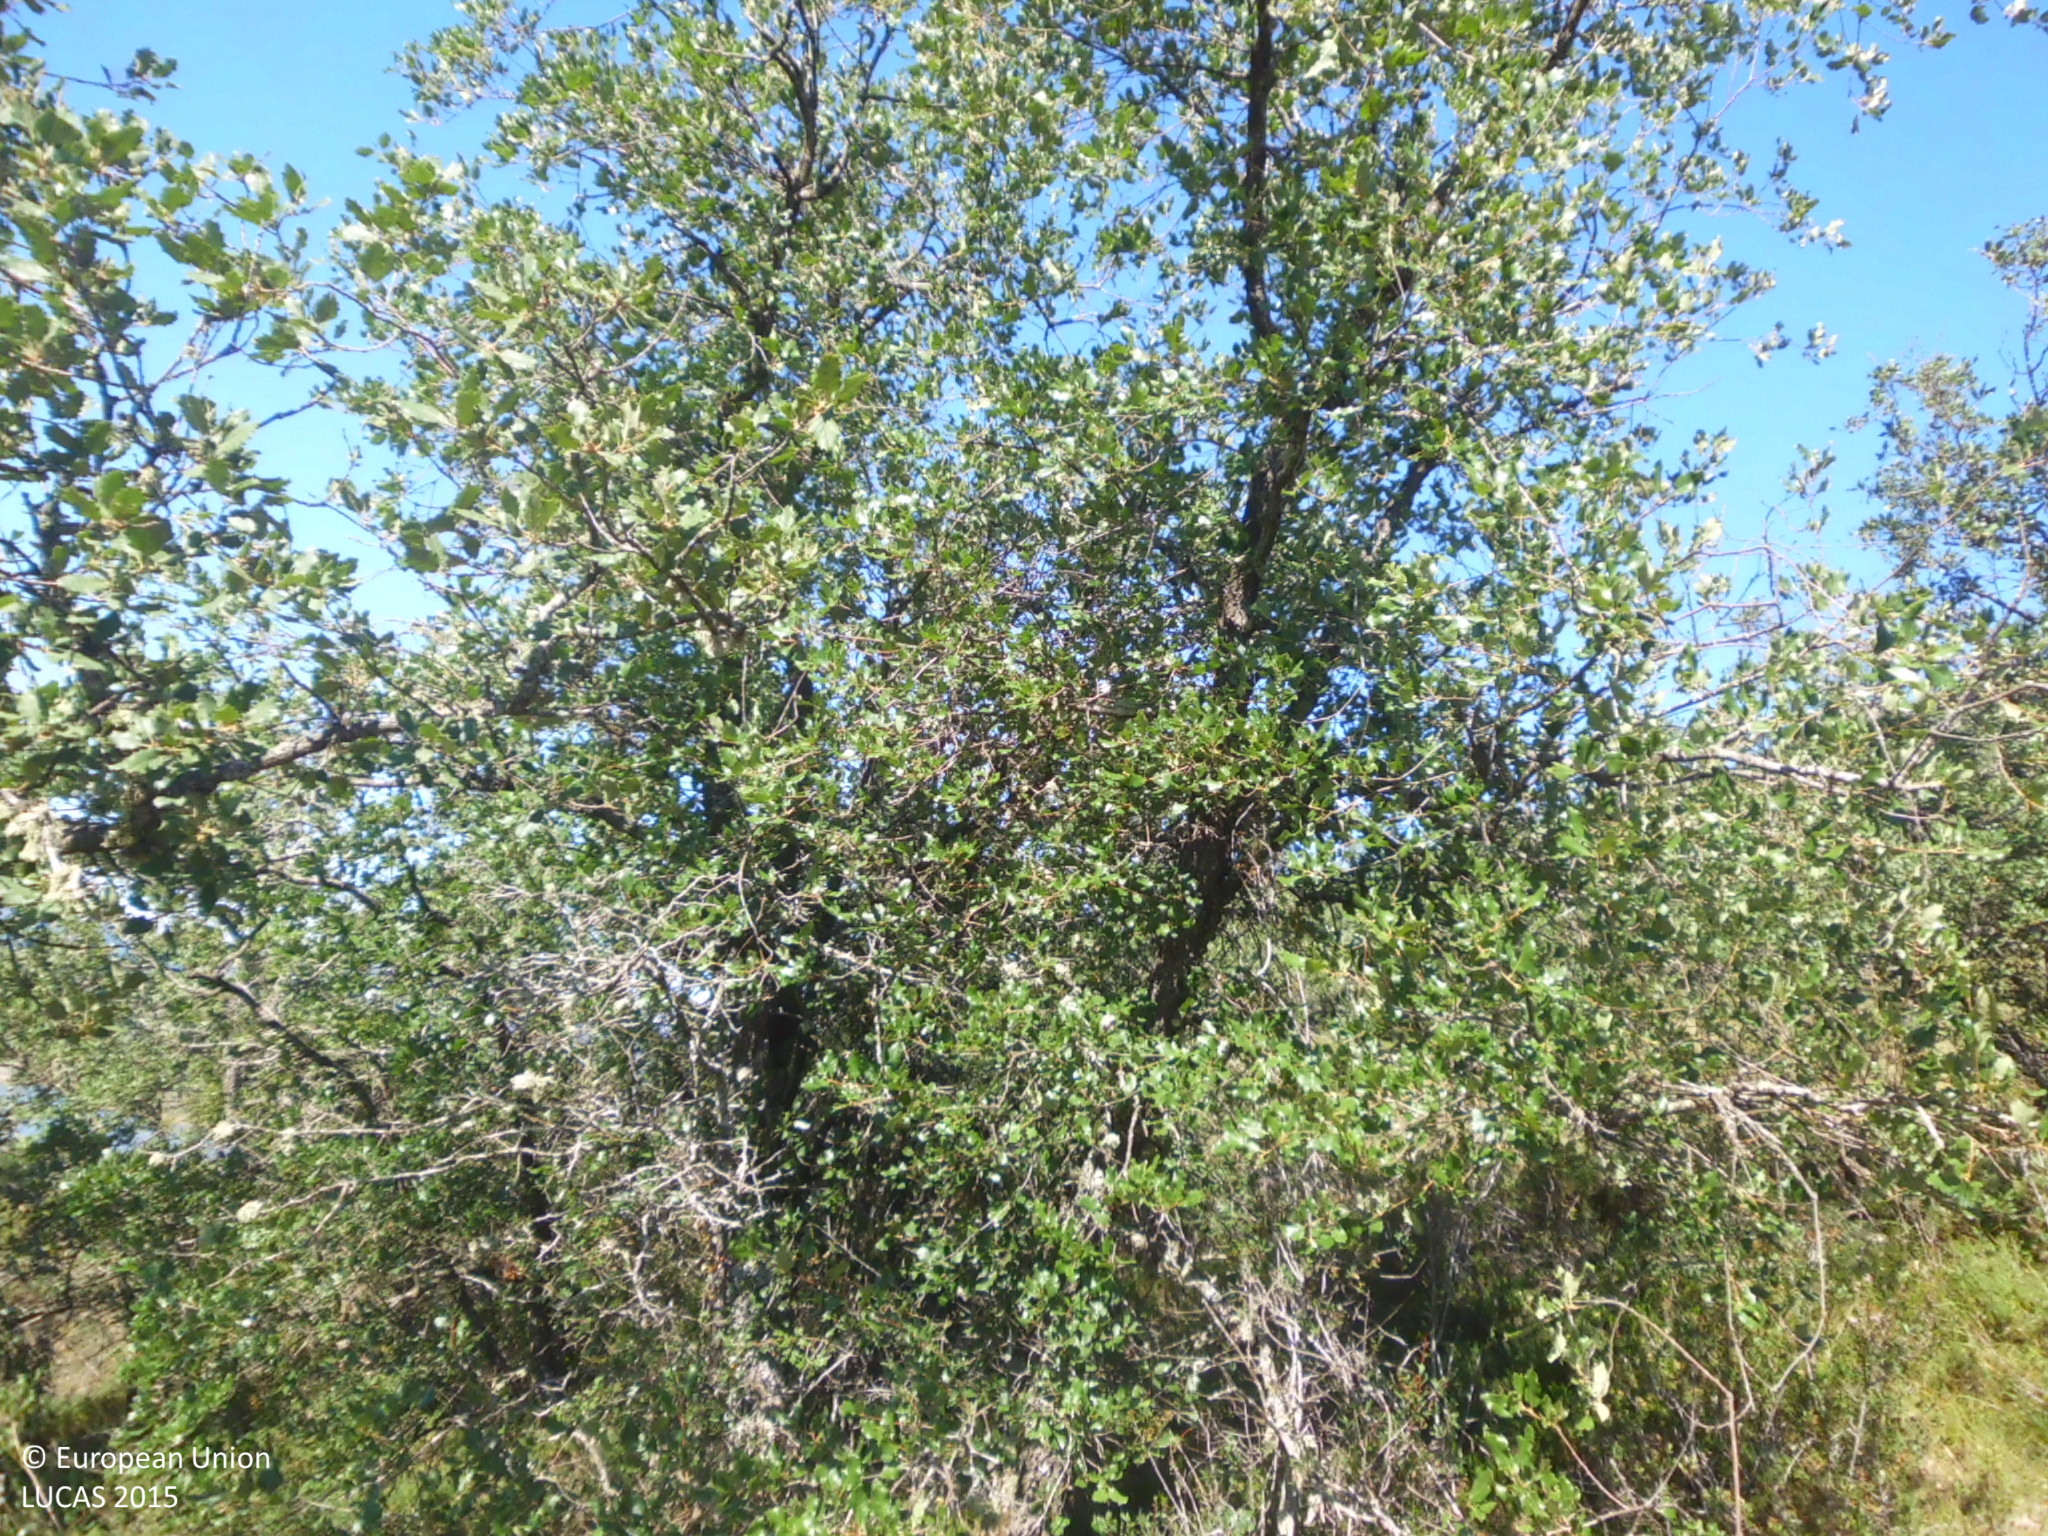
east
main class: Woodland
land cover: Broadleaved woodland
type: broadleaved evergreen forest
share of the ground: 25 - 50 %
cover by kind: broadleaved forest trees 40 %, herbaceous plants 30 %, consolidated bare surface 20 %, shrubs 10 %
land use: Semi-natural and natural areas not in use
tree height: > 5 m
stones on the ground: 10 - 25 %
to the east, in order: Broadleaved woodland
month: July
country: ES
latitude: 42.7953
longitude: -4.3689
